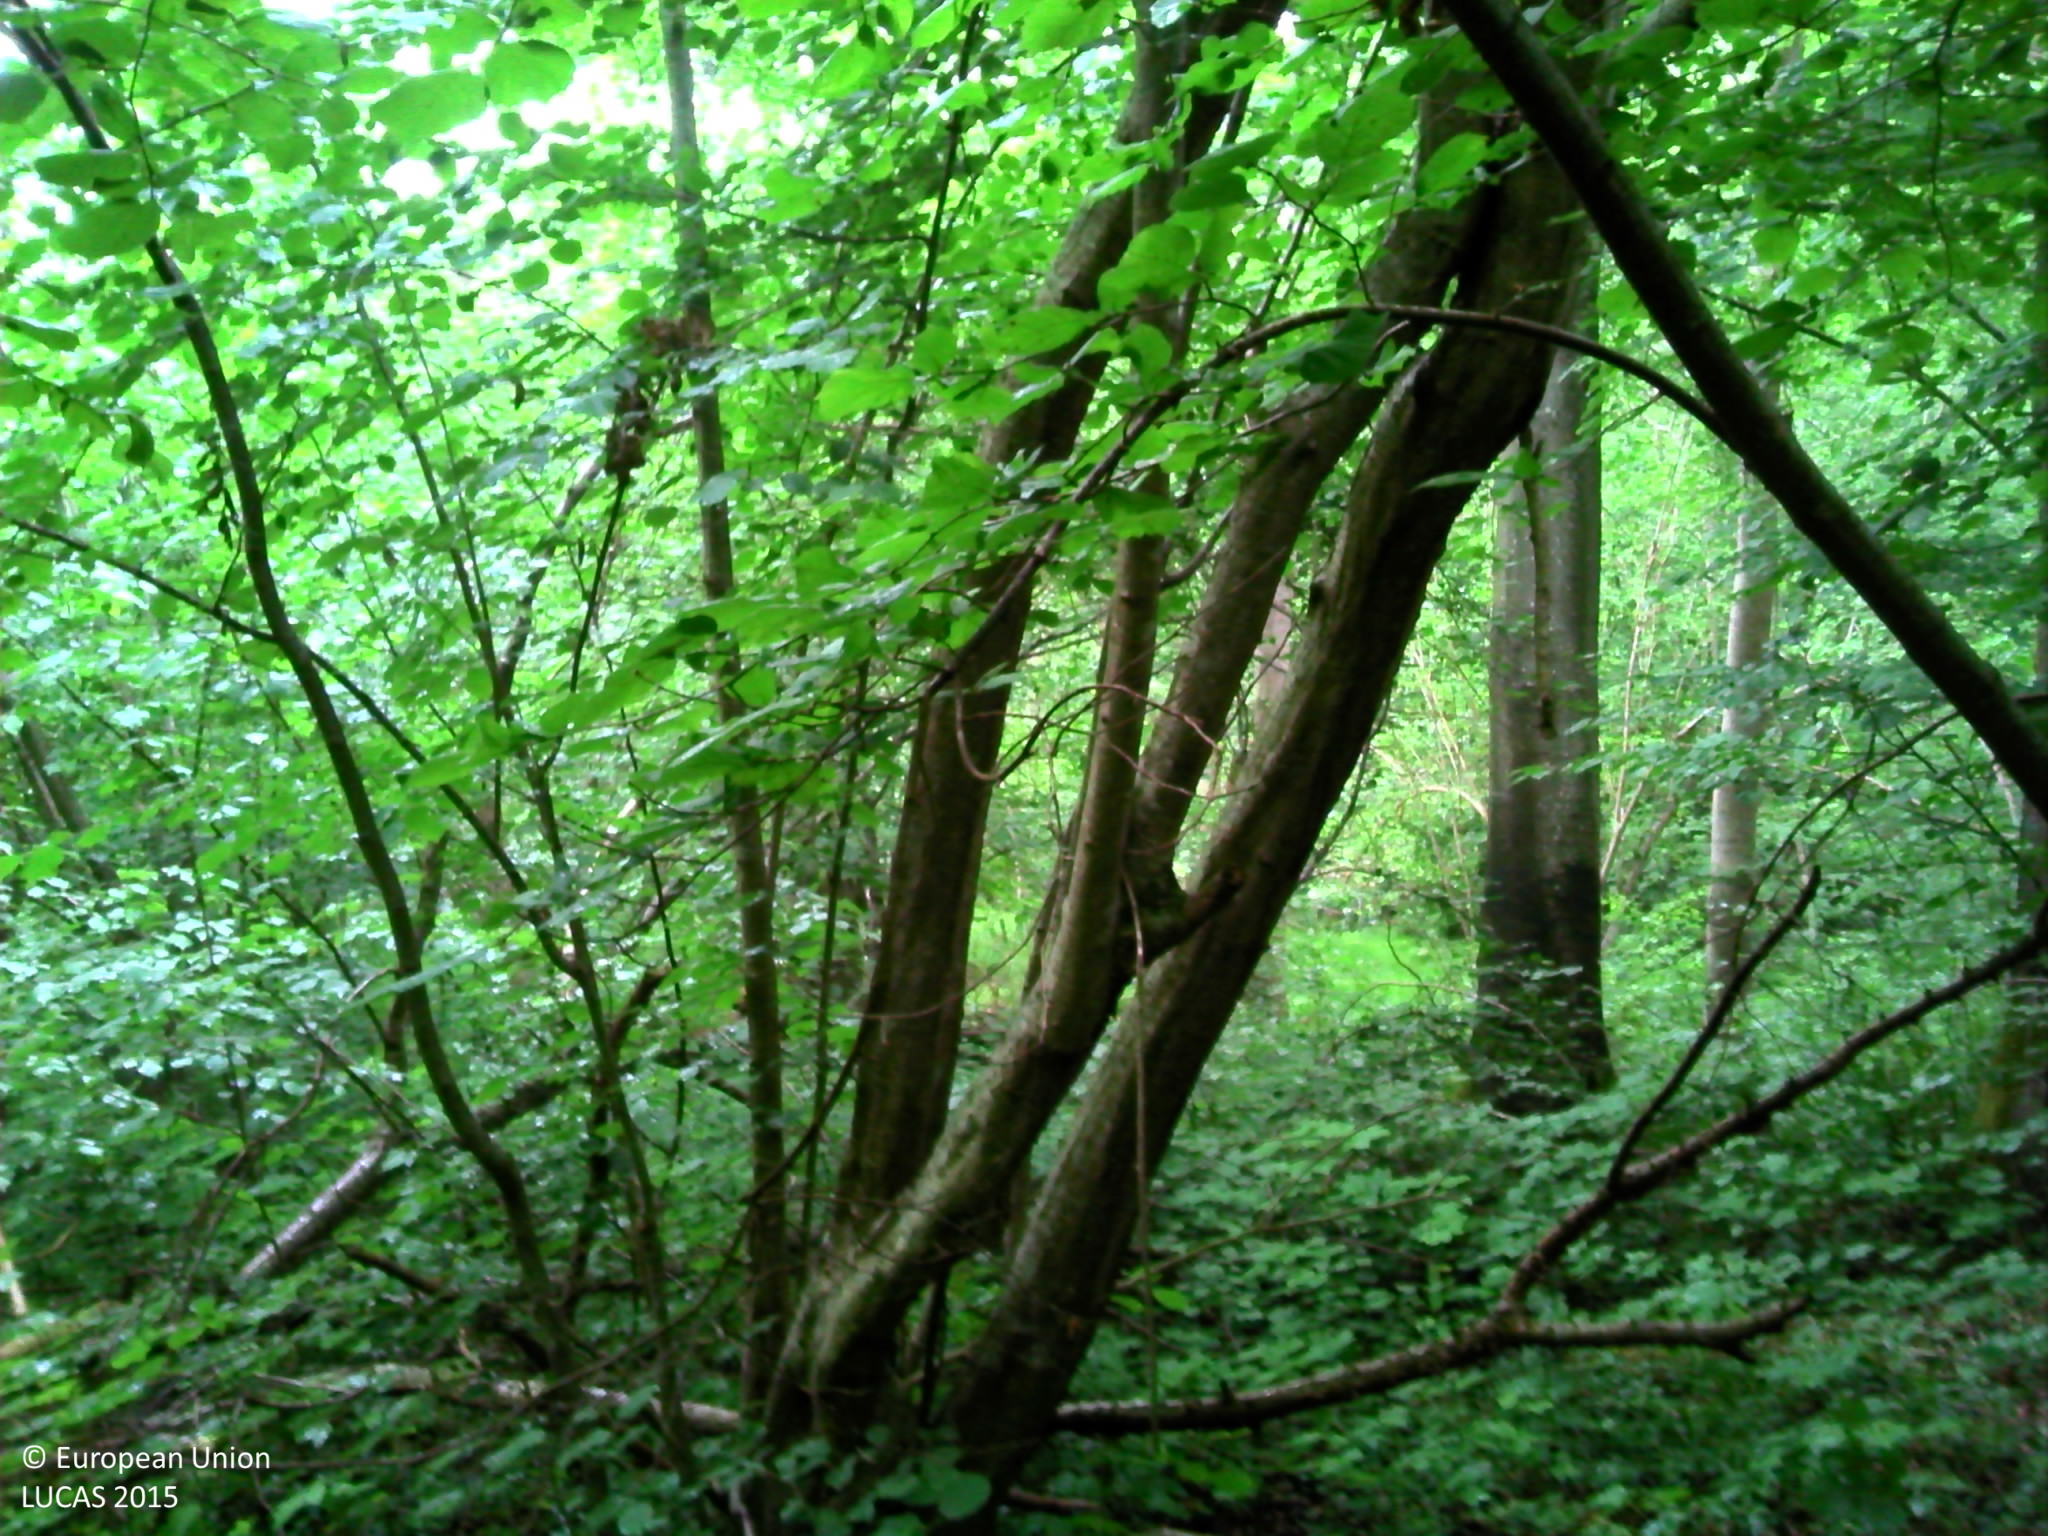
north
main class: Woodland
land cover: Broadleaved woodland
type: acidophilous oak and oak-birch forest
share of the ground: > 75 %
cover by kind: broadleaved forest trees 90 %, shrubs 5 %, herbaceous plants 5 %
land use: Forestry
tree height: > 5 m
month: June
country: FR
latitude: 49.3276
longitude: 2.8488
